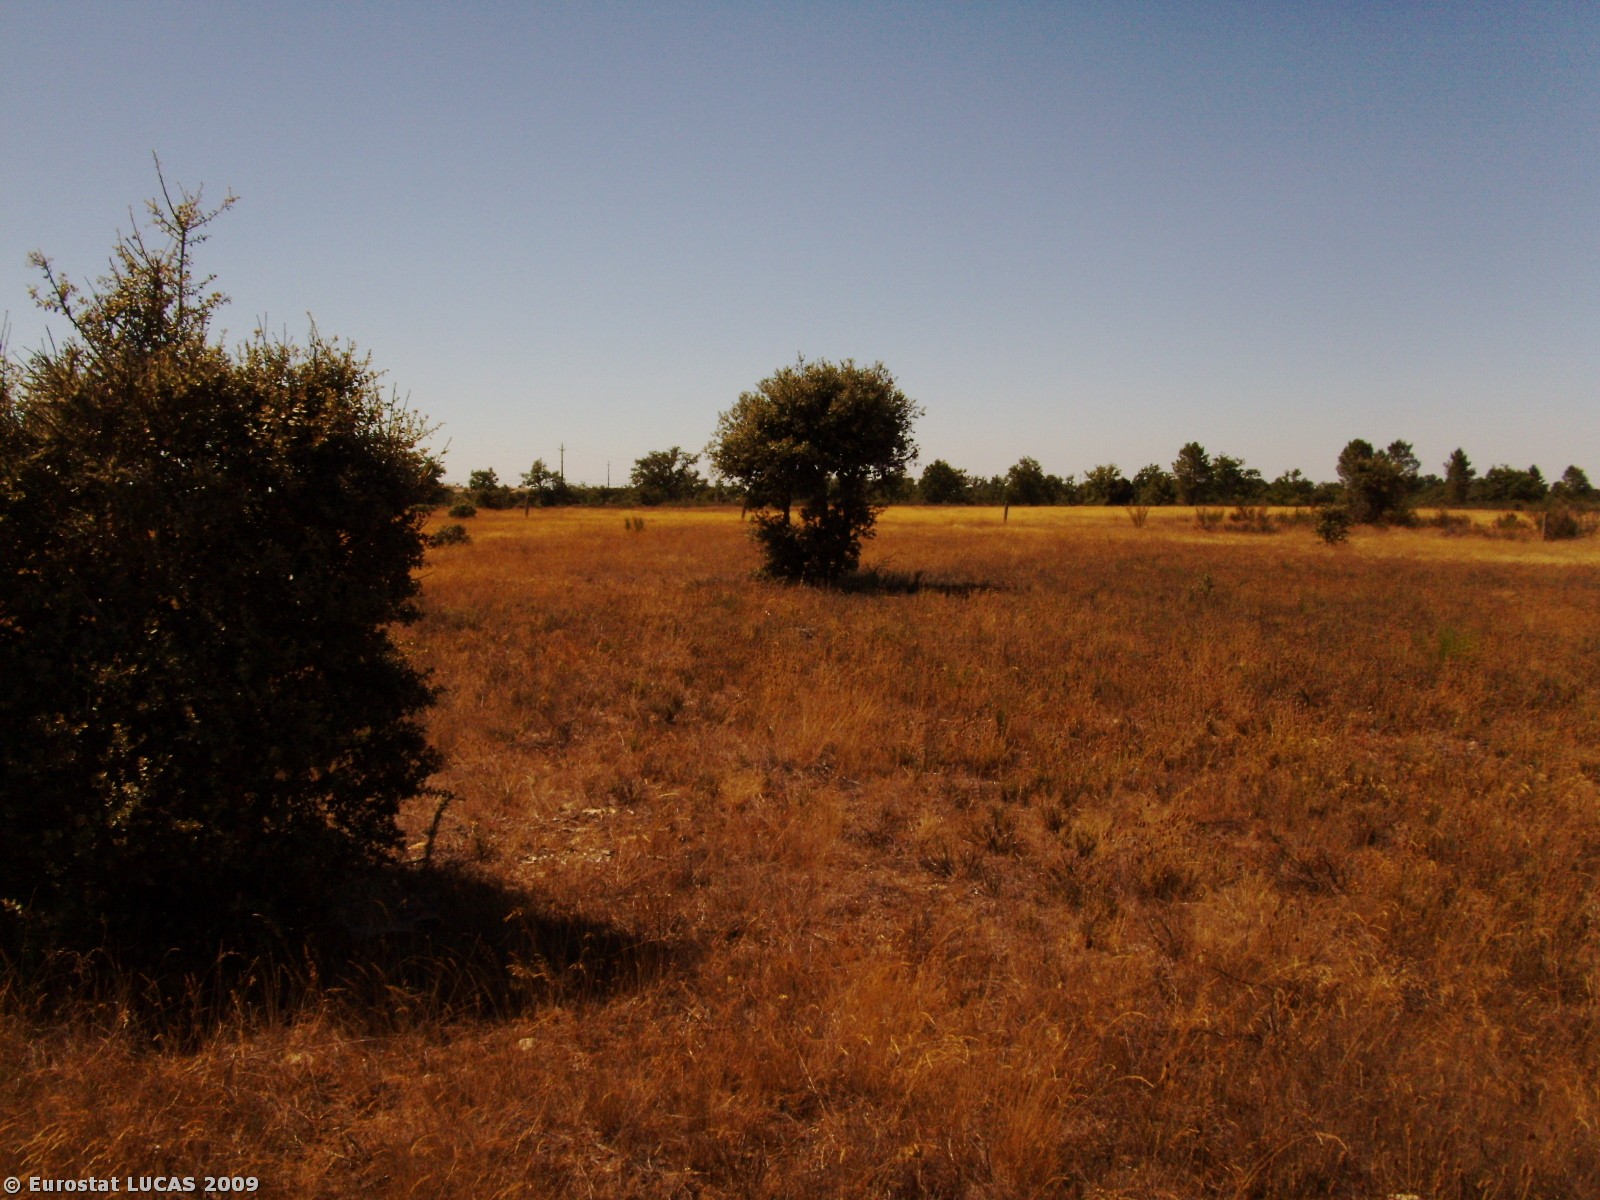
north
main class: Woodland
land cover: Broadleaved woodland
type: broadleaved evergreen forest
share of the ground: 25 - 50 %
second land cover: Spontaneously vegetated surfaces
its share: 50 - 75 %
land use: Forestry
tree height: > 5 m
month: July
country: PT
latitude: 40.5310
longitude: -6.8474
